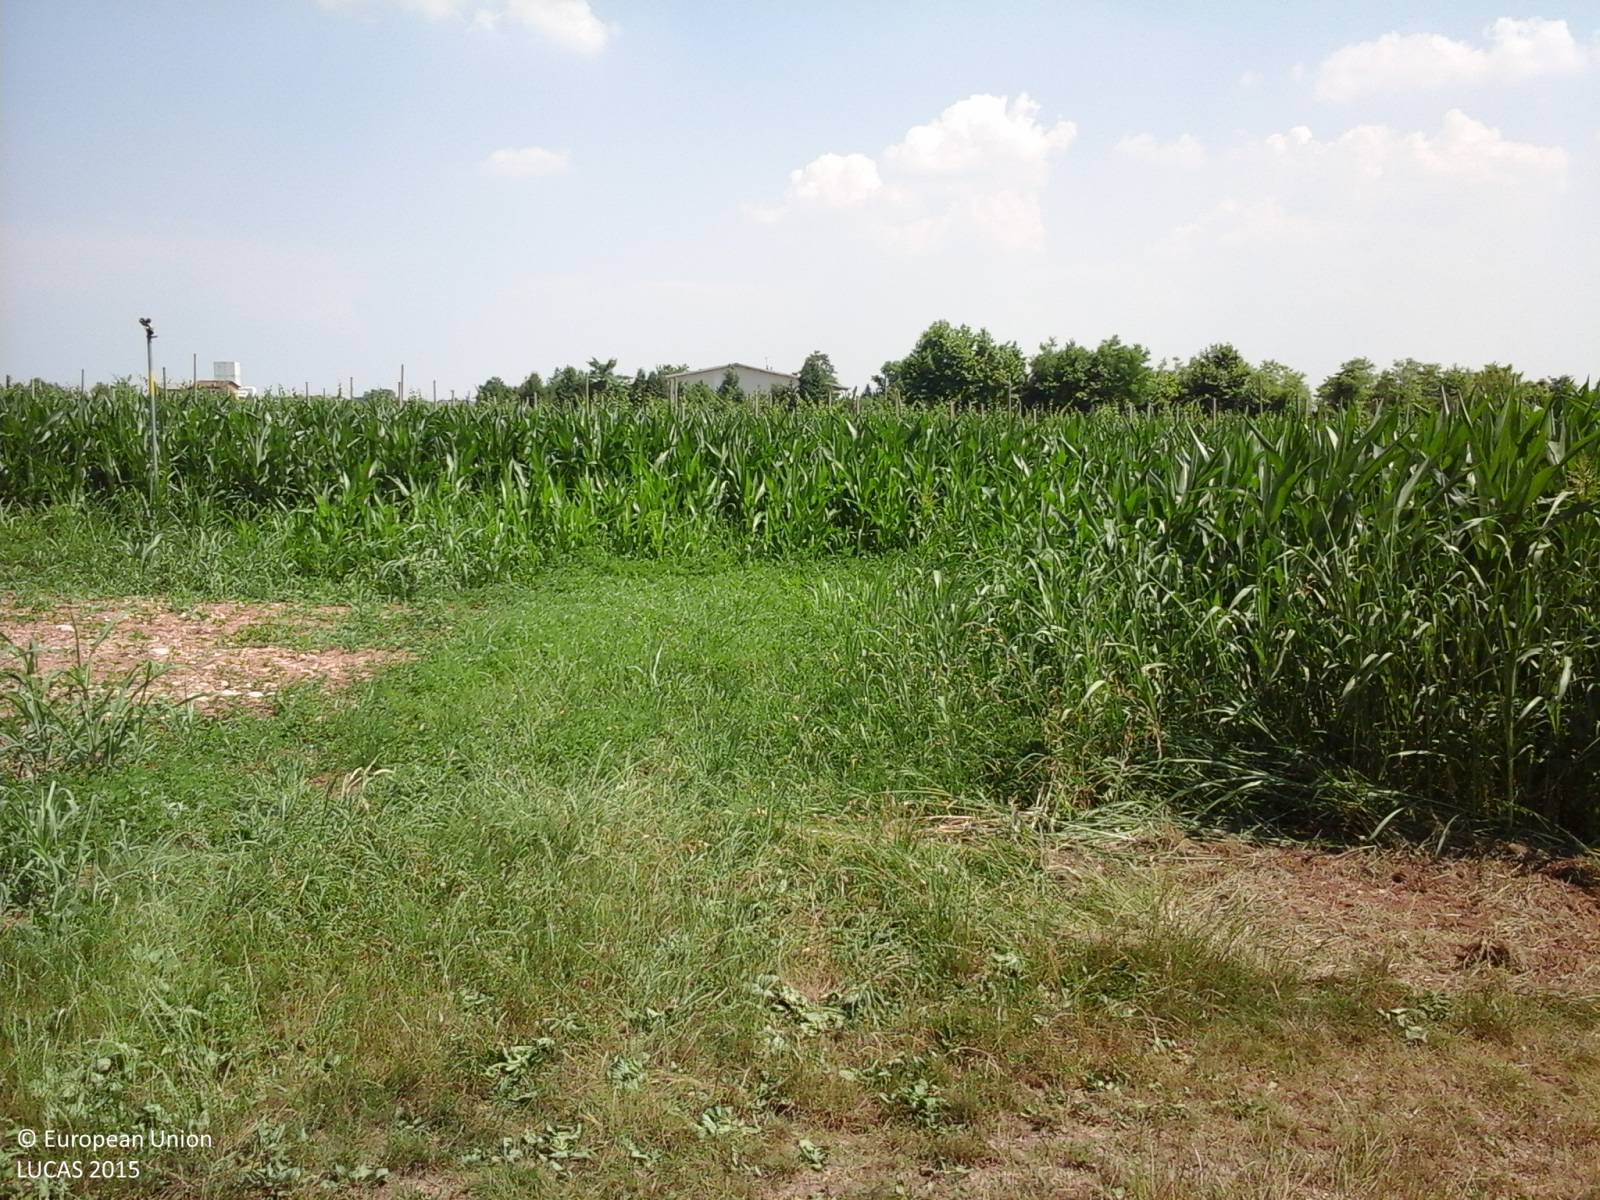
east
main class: Cropland
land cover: Common wheat
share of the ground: > 75 %
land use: Agriculture (excluding fallow land and kitchen gardens)
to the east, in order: Common wheat; Tracks; Grass margins; Soya; Grass margins; Maize; Grass margins; Vineyards; Grass margins; Maize; Tracks; Soya
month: June
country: IT
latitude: 45.9960
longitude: 12.5661
